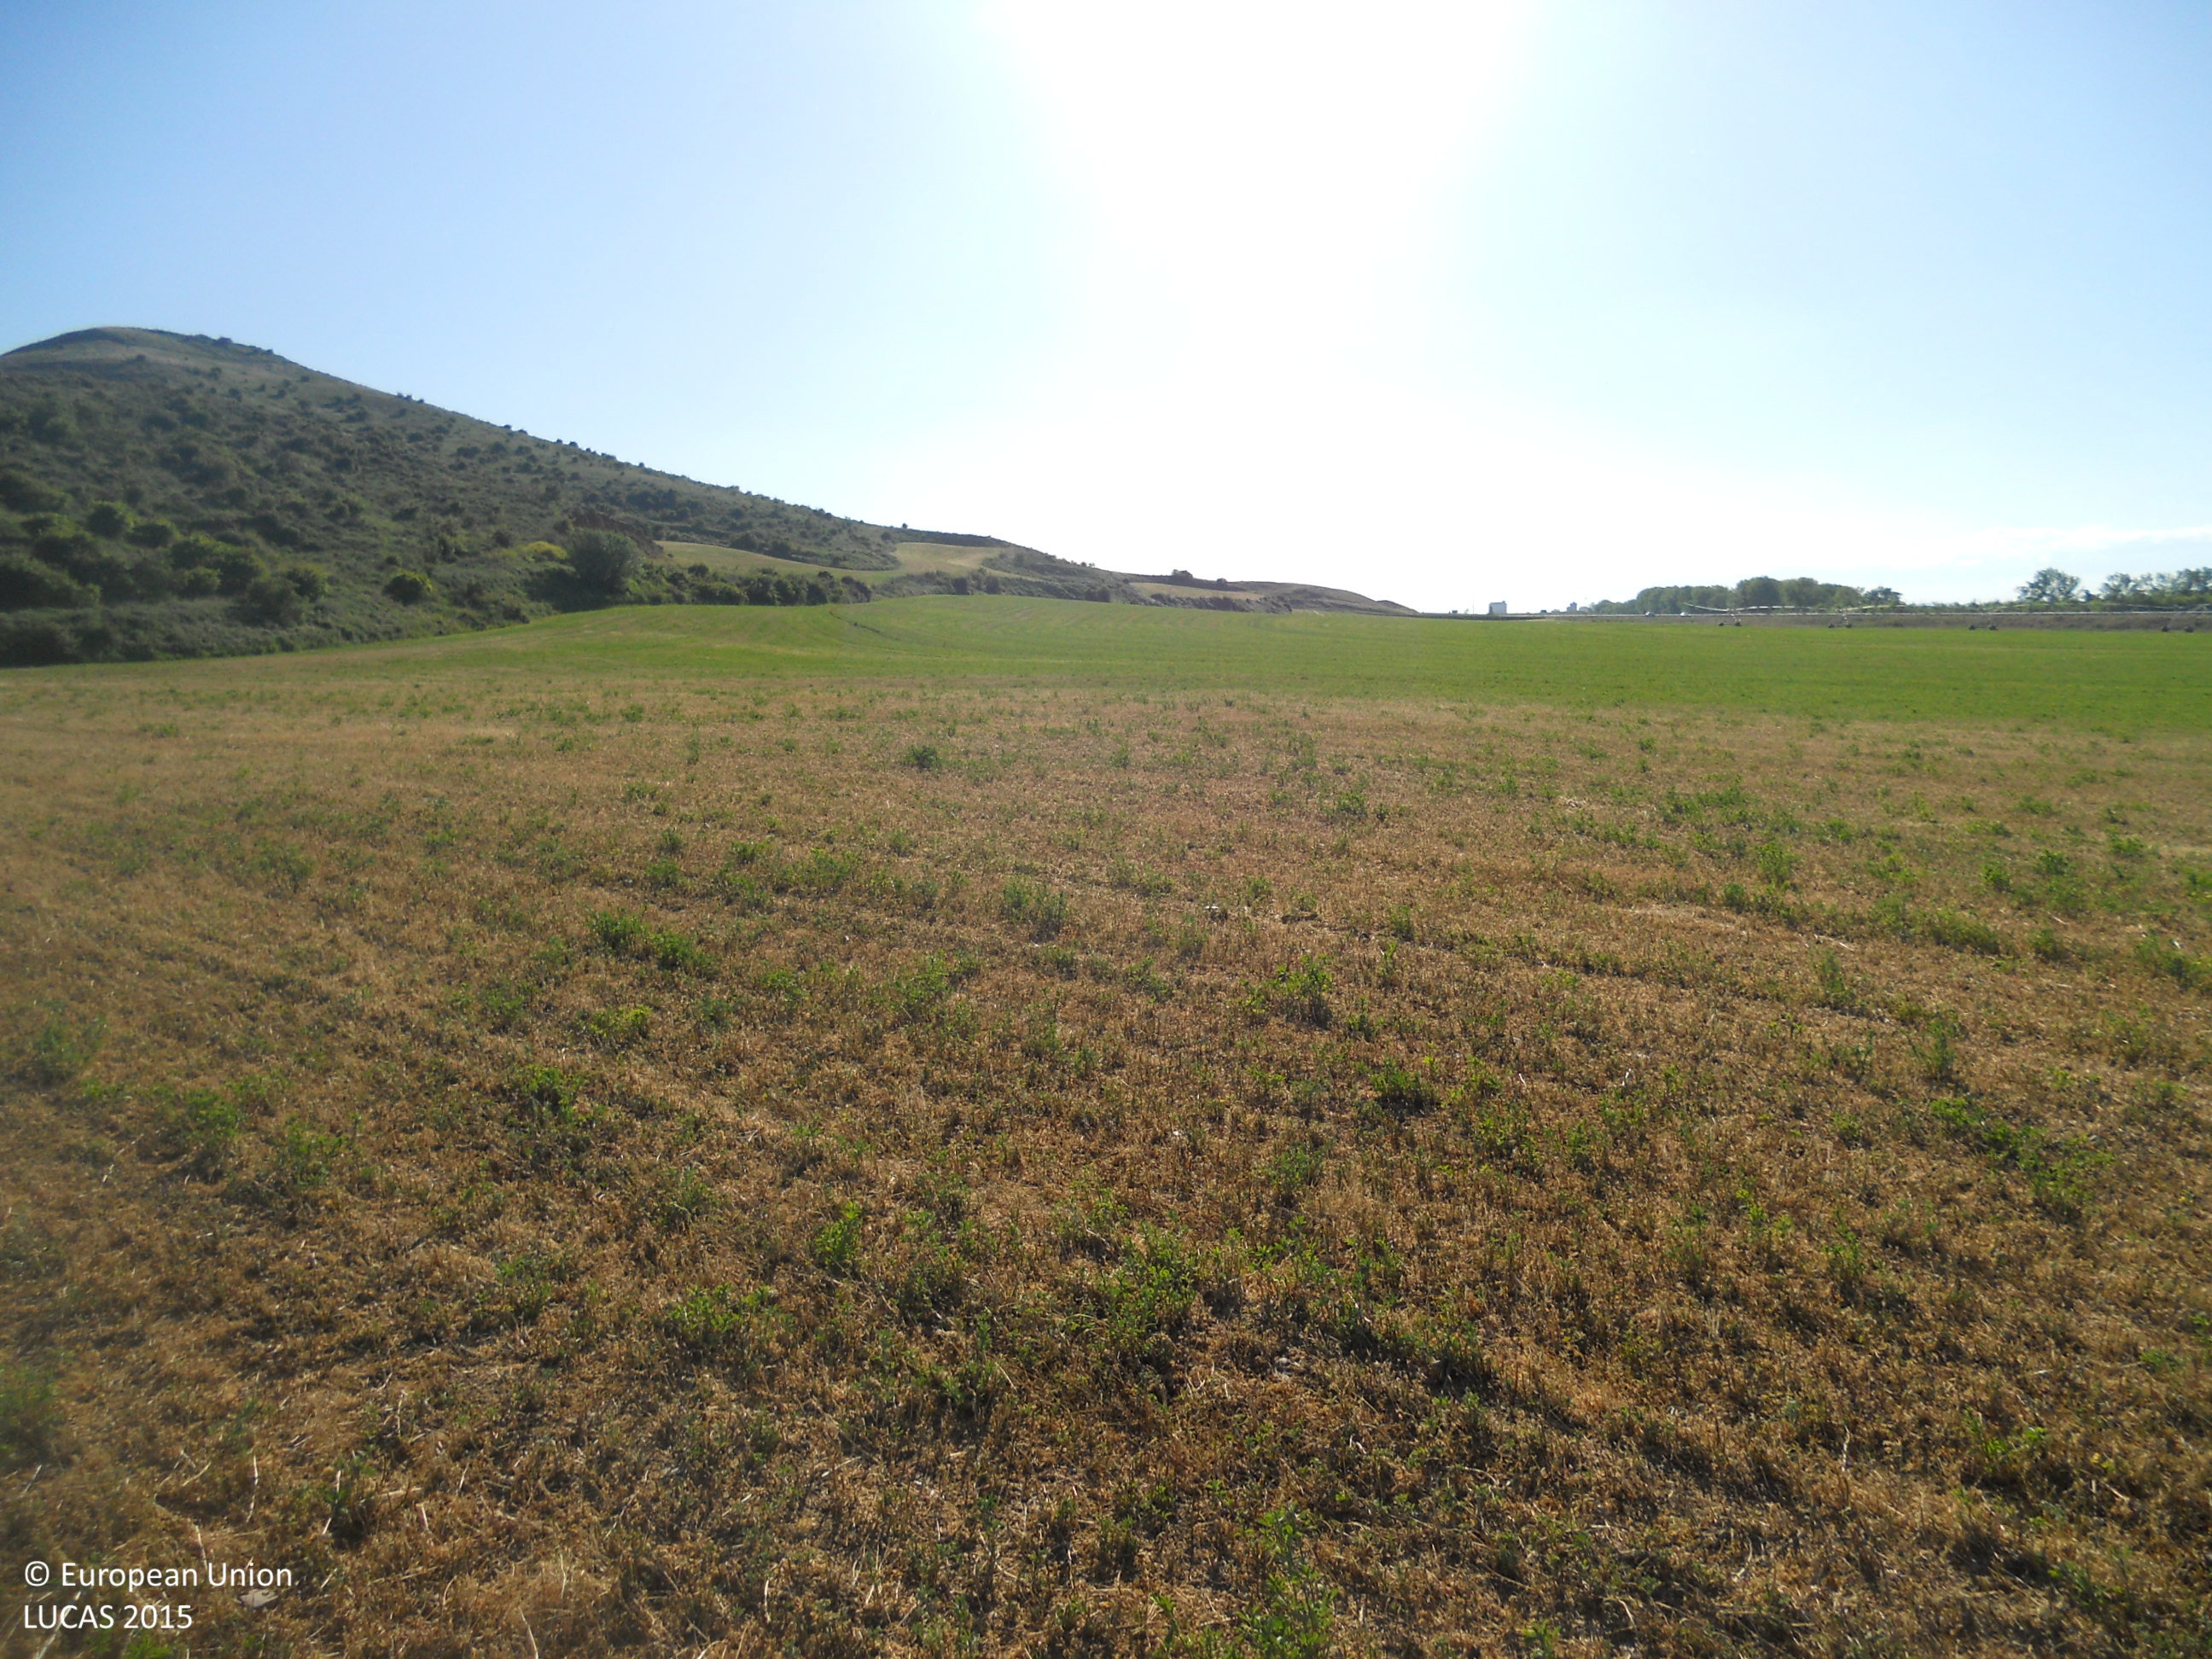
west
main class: Cropland
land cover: Lucerne
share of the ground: > 75 %
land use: Agriculture (excluding fallow land and kitchen gardens)
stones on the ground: < 10 %
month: May
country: ES
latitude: 42.3993
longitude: -4.3220
